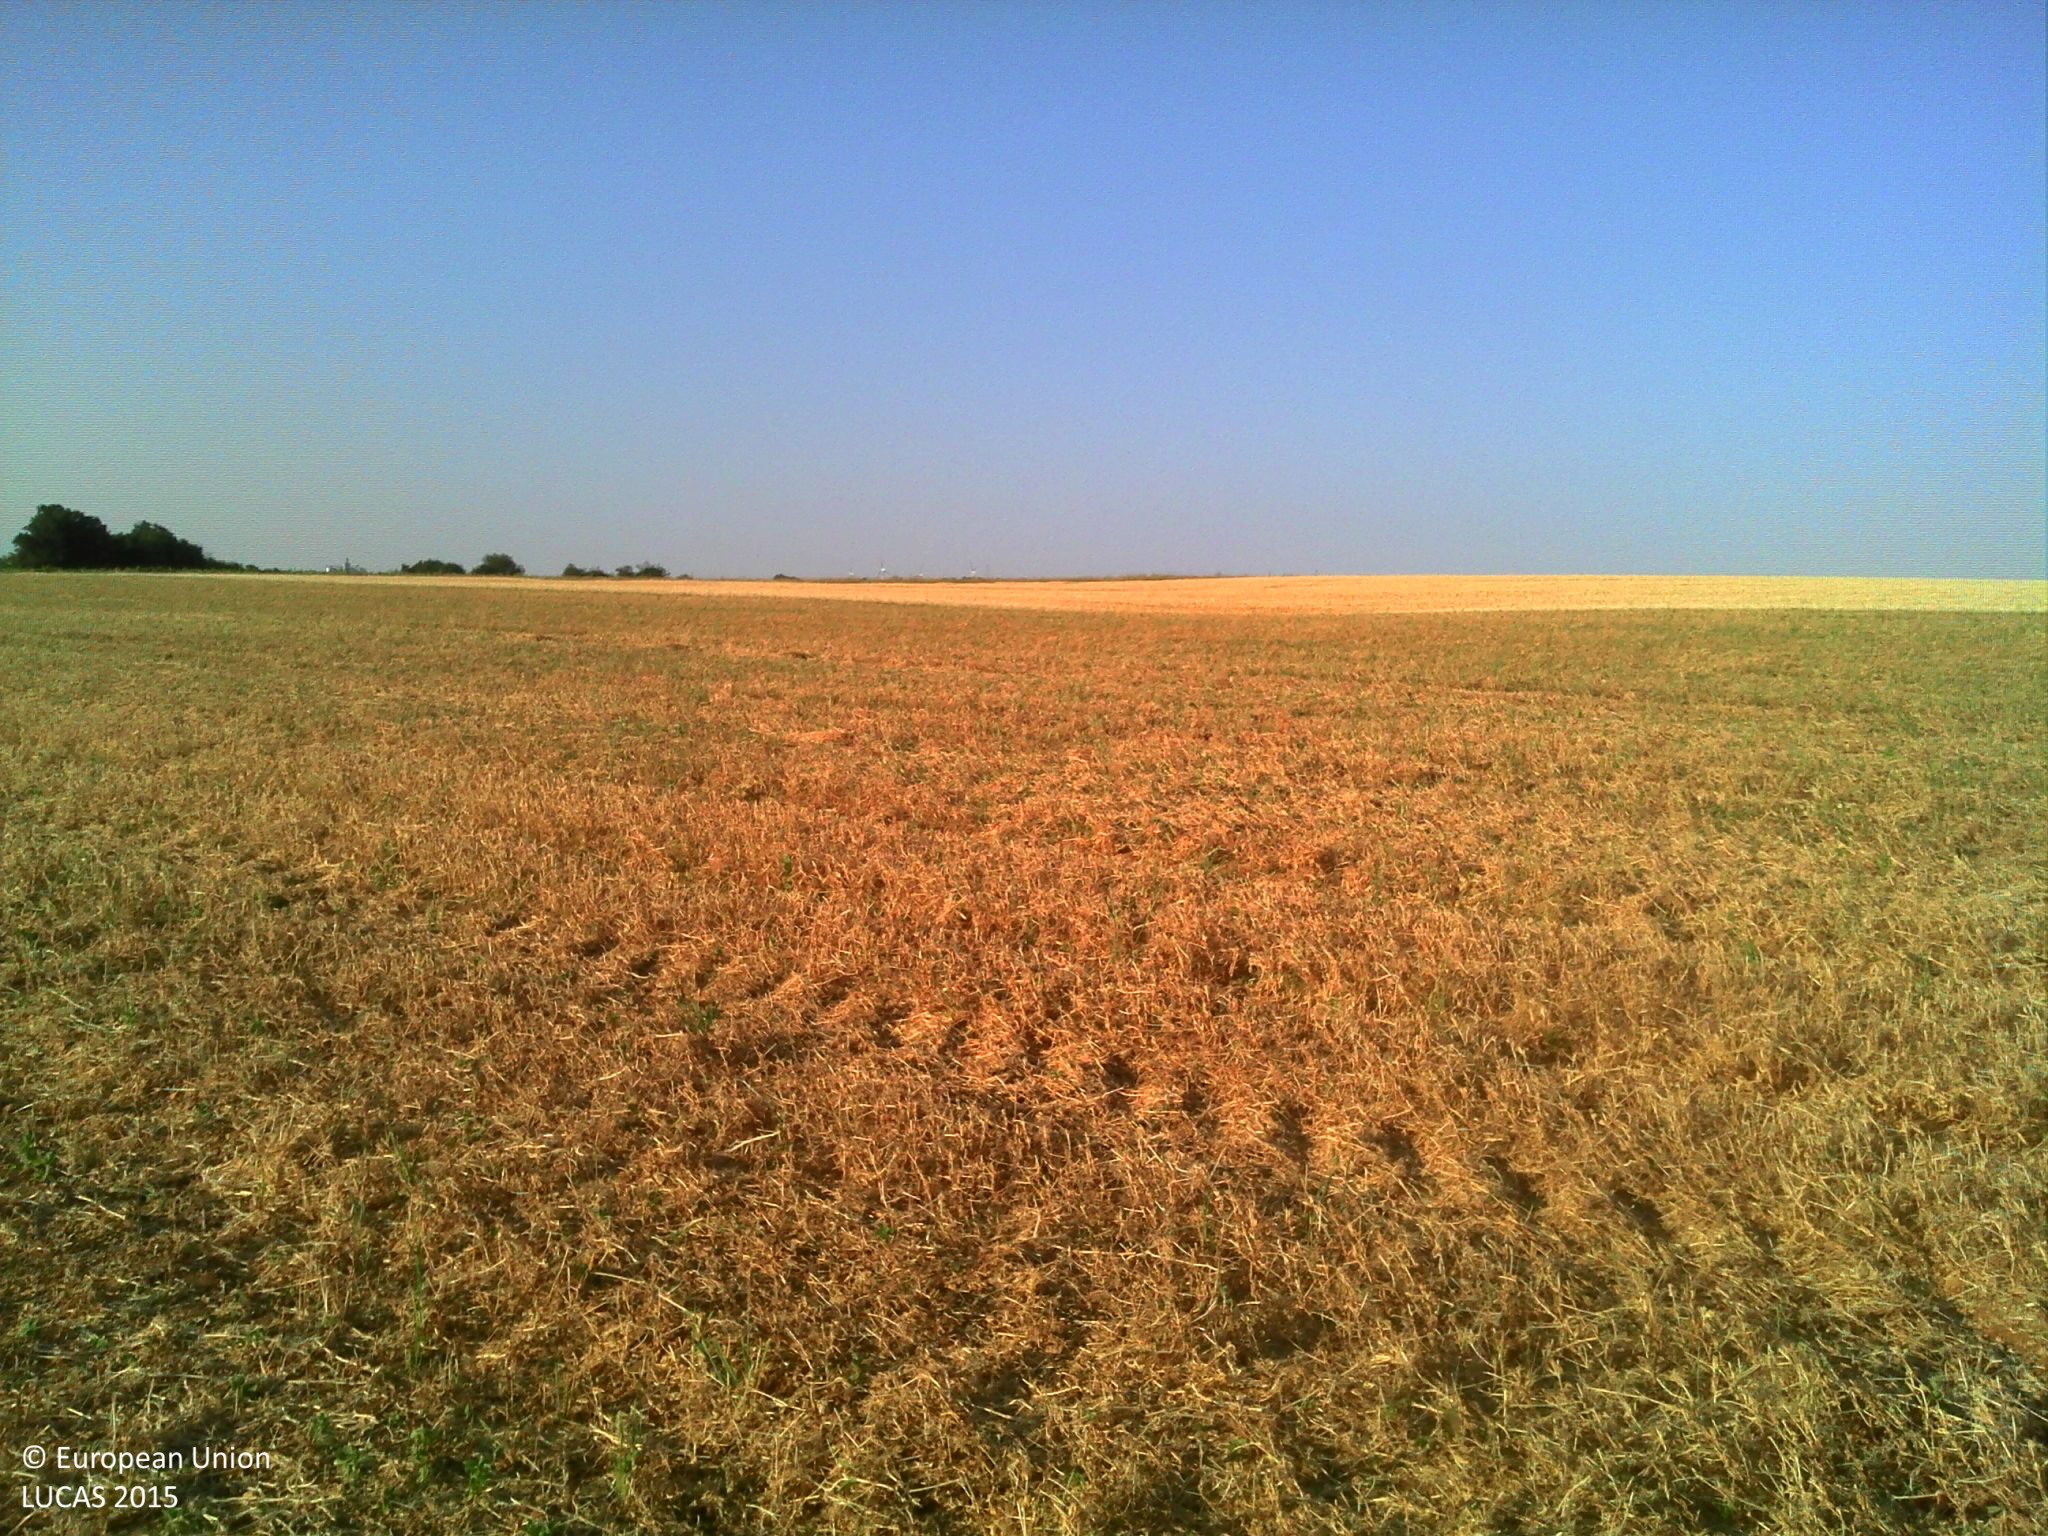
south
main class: Cropland
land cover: Dry pulses
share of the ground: > 75 %
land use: Agriculture (excluding fallow land and kitchen gardens)
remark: Harvested field
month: July
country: FR
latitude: 47.7054
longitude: 3.4786
